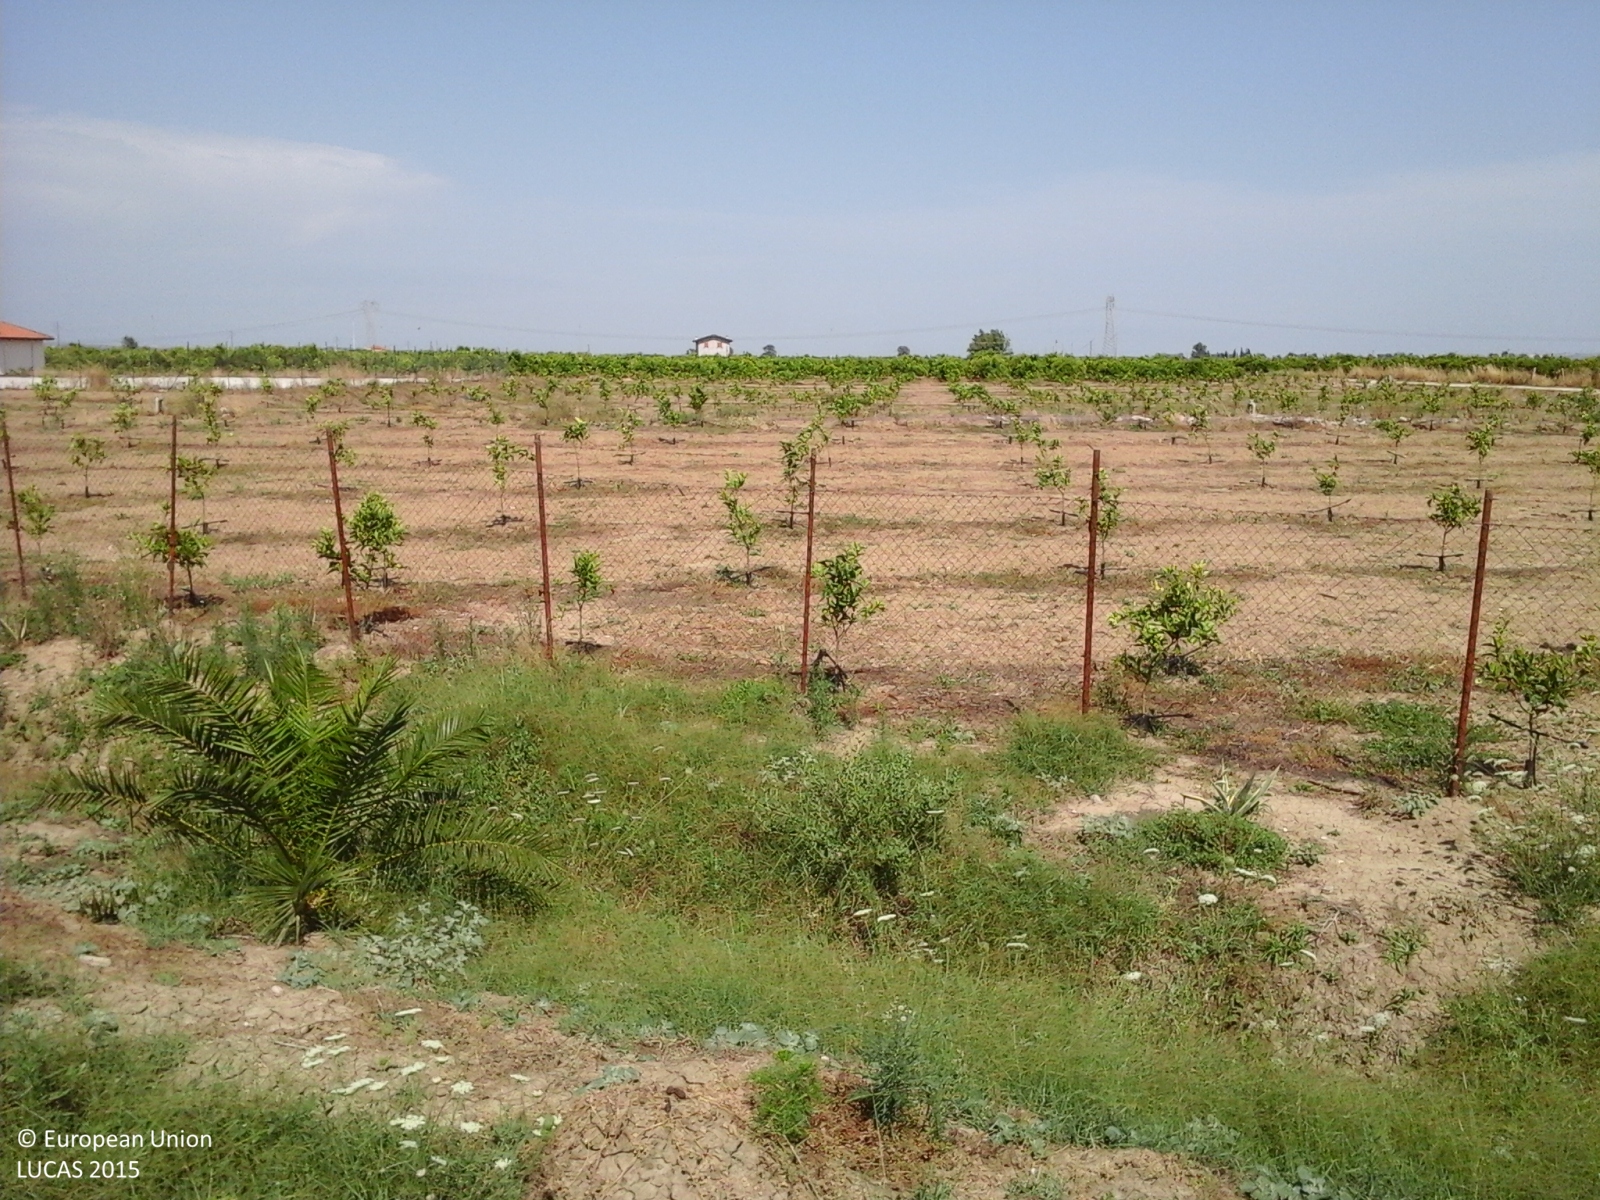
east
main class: Cropland
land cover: Oranges
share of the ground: > 75 %
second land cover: Spontaneously vegetated surfaces
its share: > 75 %
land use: Agriculture (excluding fallow land and kitchen gardens)
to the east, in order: Oranges; Spontaneously vegetated surfaces; Grass margins; Tracks; Grass margins; Oranges; Grass margins; Tracks; Grass margins; Oranges
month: June
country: IT
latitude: 37.4415
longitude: 14.8585
